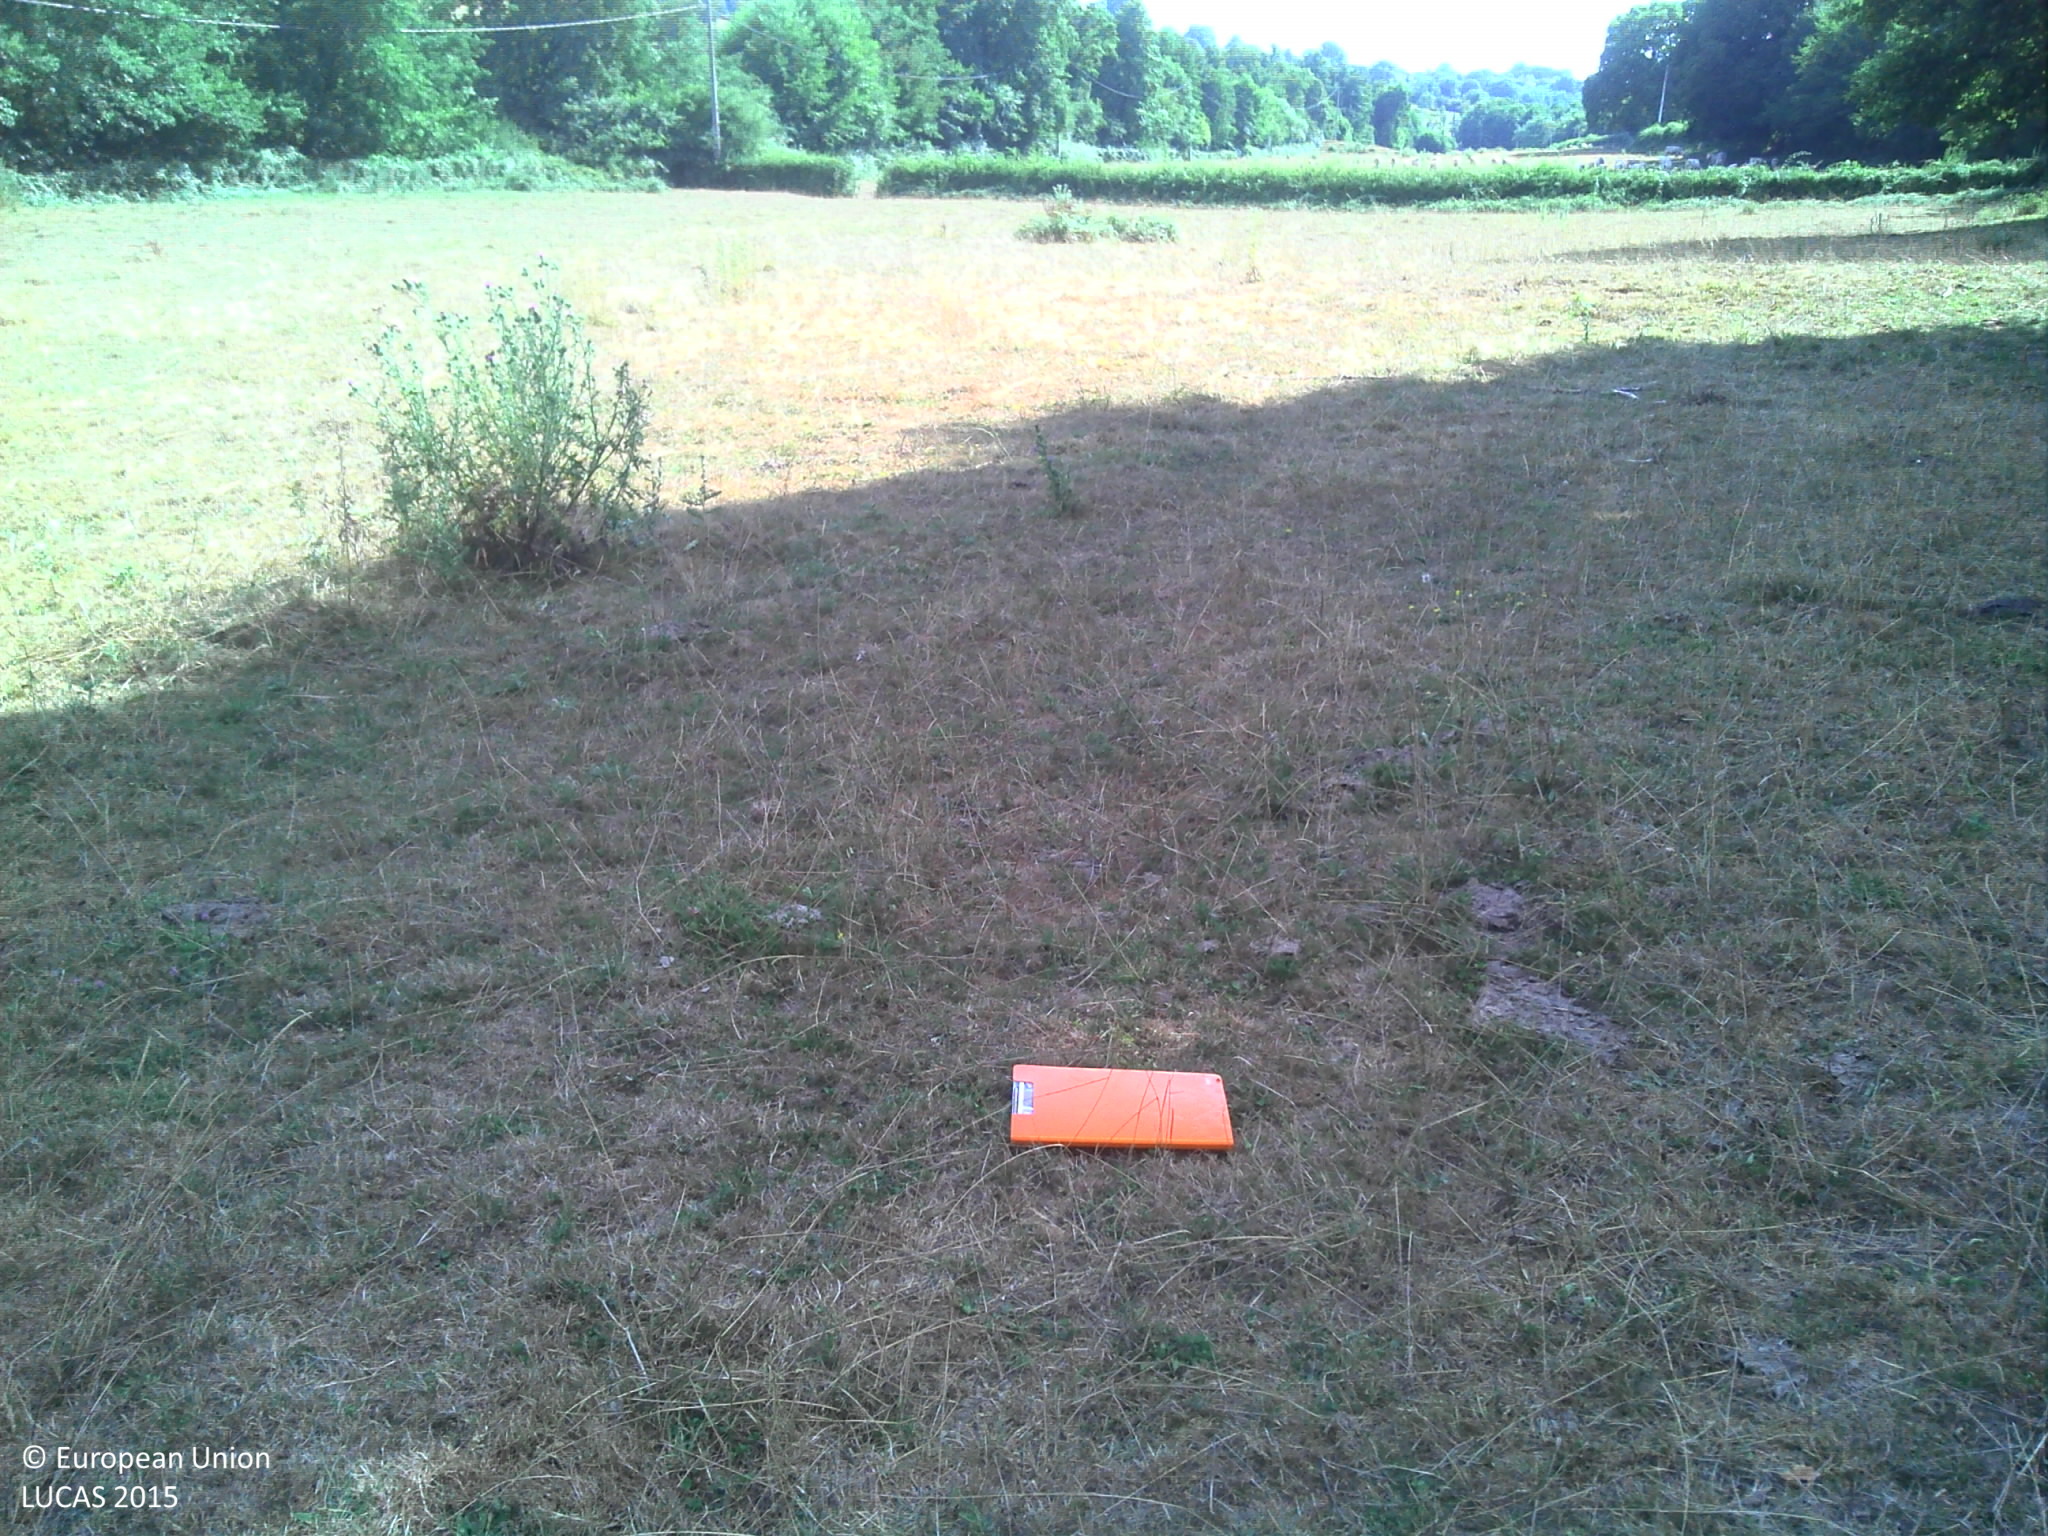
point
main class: Grassland
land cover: Grassland without tree/shrub cover
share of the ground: > 75 %
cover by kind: herbaceous plants 95 %, shrubs 5 %
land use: Agriculture (excluding fallow land and kitchen gardens)
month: July
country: FR
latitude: 46.4817
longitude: 2.9761
